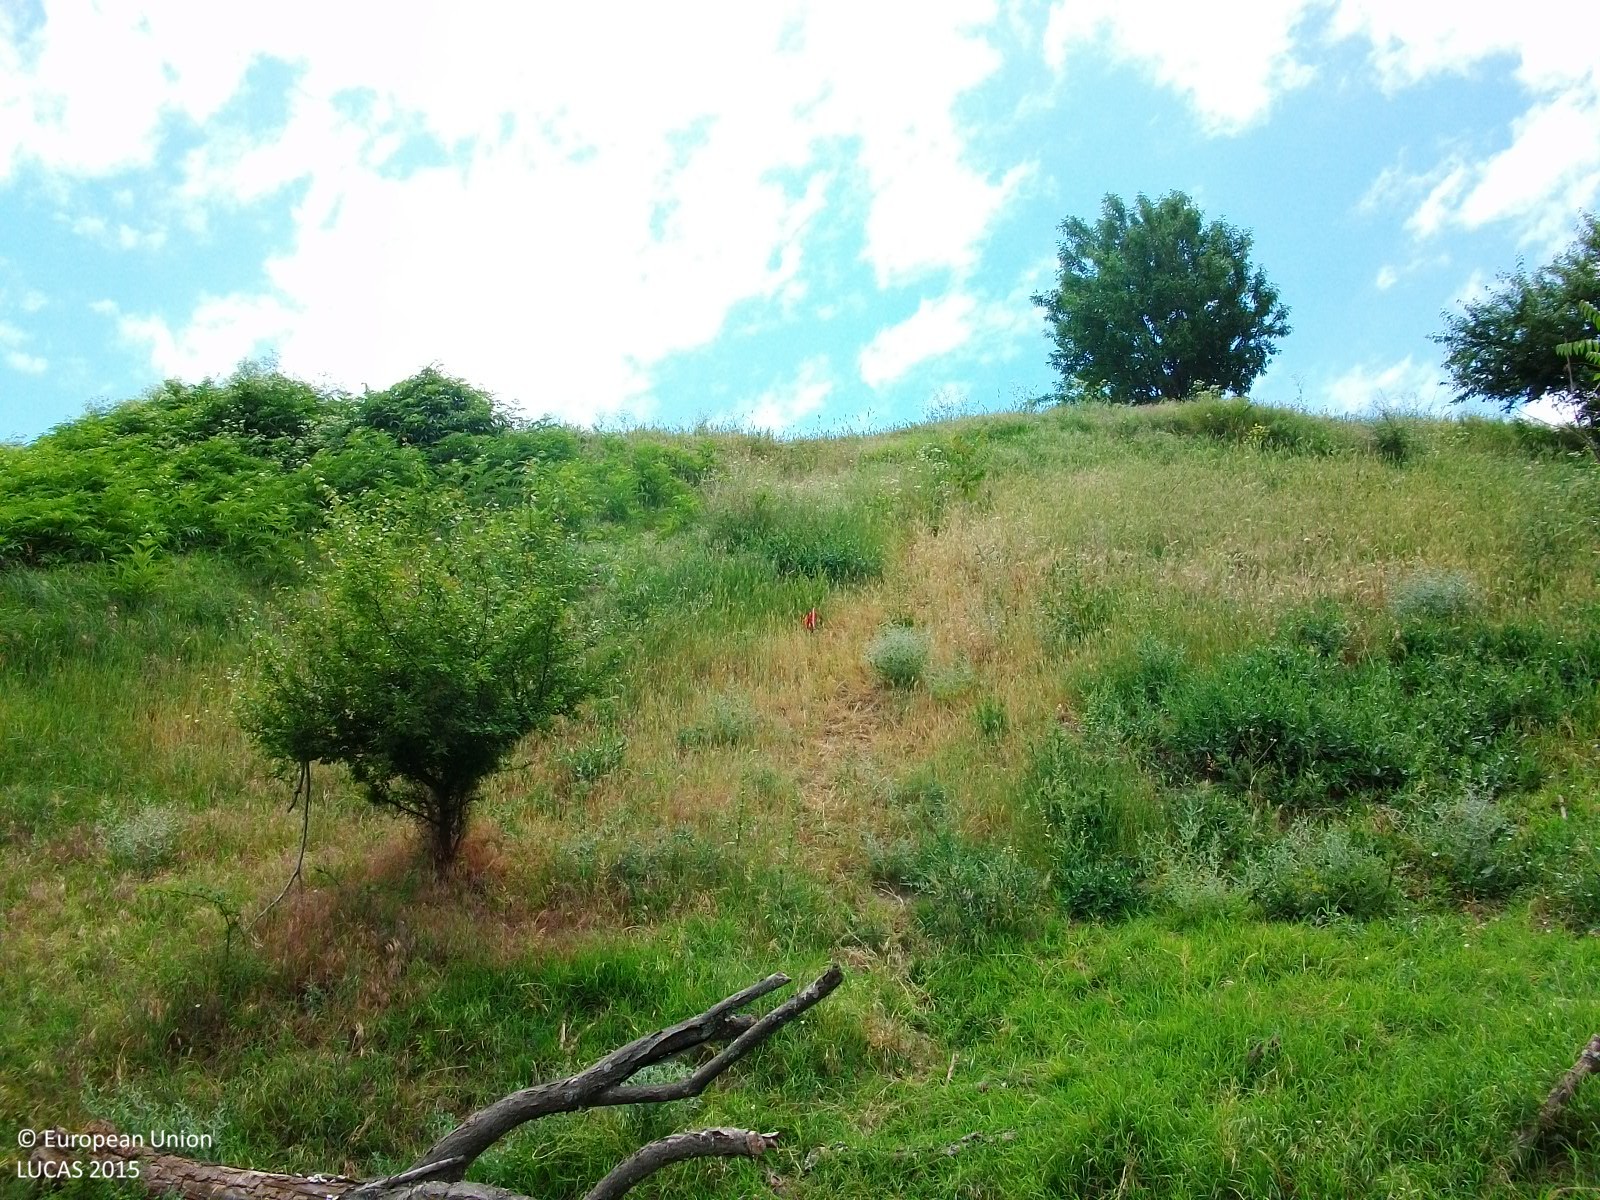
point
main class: Grassland
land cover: Grassland with sparse tree/shrub cover
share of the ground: > 75 %
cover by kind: herbaceous plants 90 %, broadleaved forest trees 5 %, shrubs 5 %
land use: Abandoned areas
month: June
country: GR
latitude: 41.7226
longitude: 26.2194
